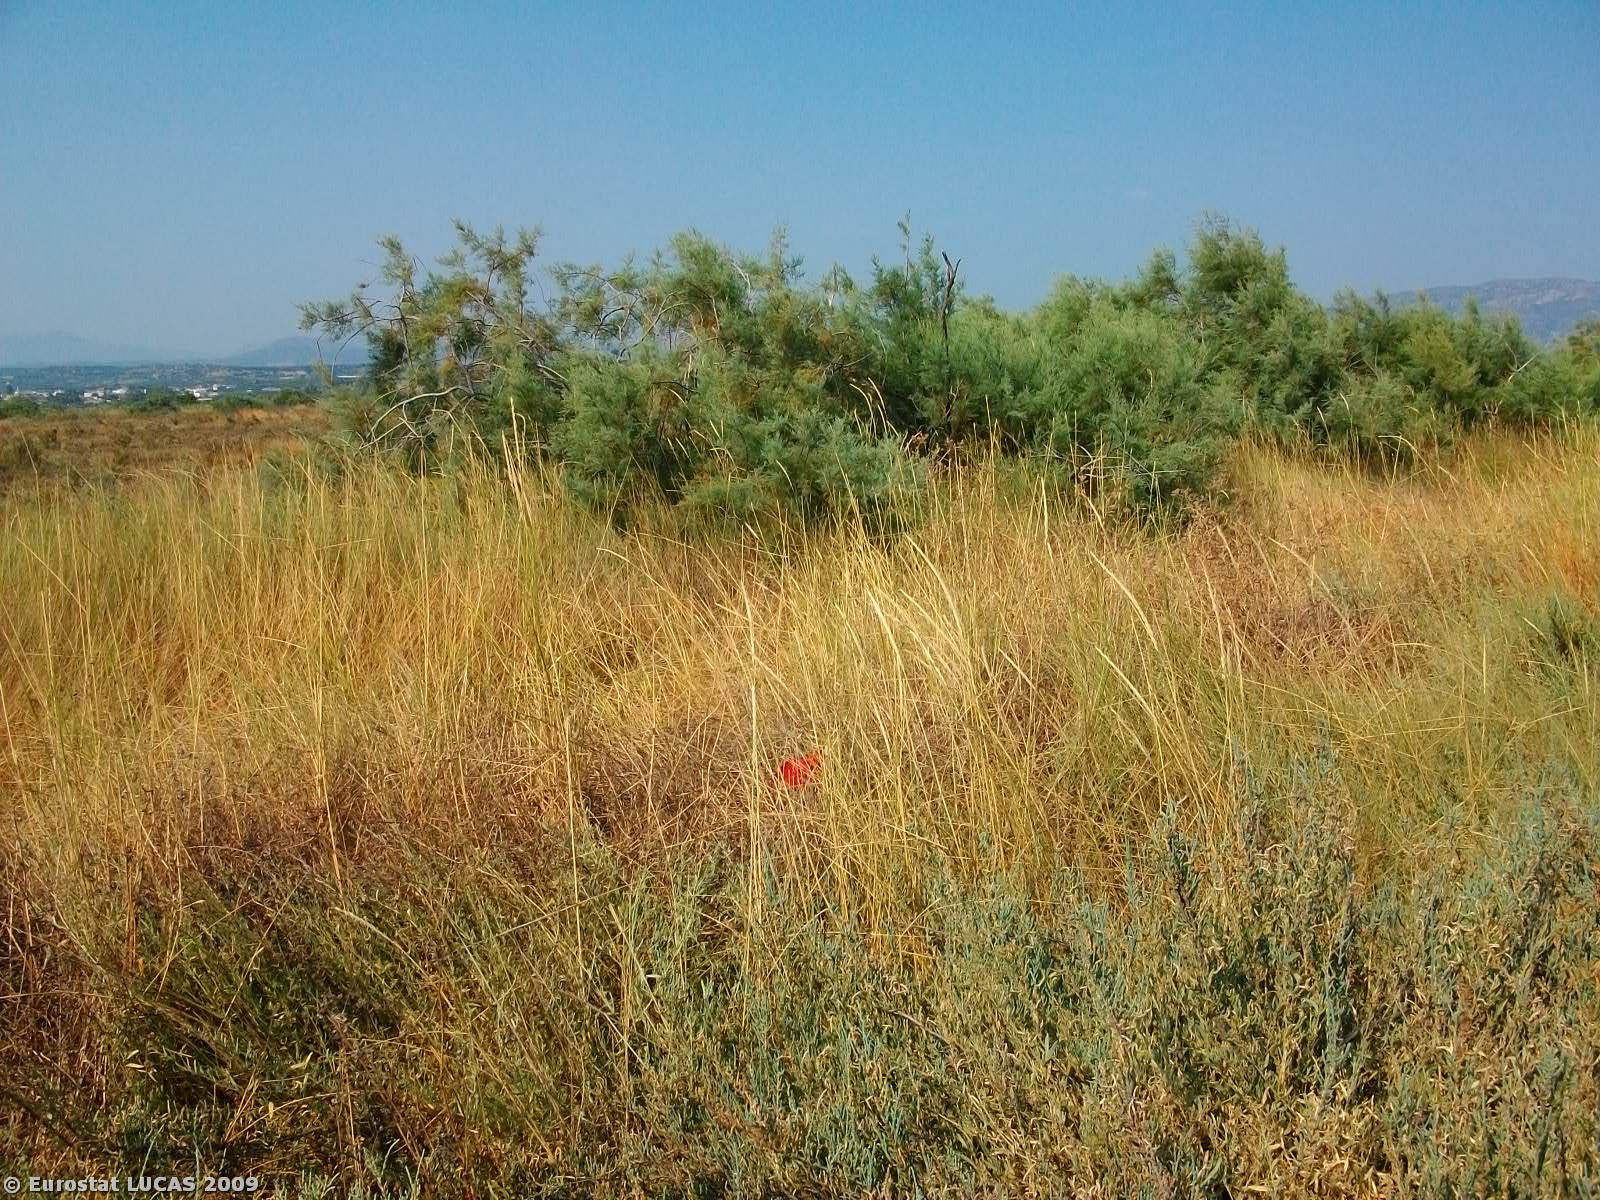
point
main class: Grassland
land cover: Spontaneously vegetated surfaces
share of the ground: > 75 %
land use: Nature reserves
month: August
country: GR
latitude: 36.8159
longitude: 22.7223
